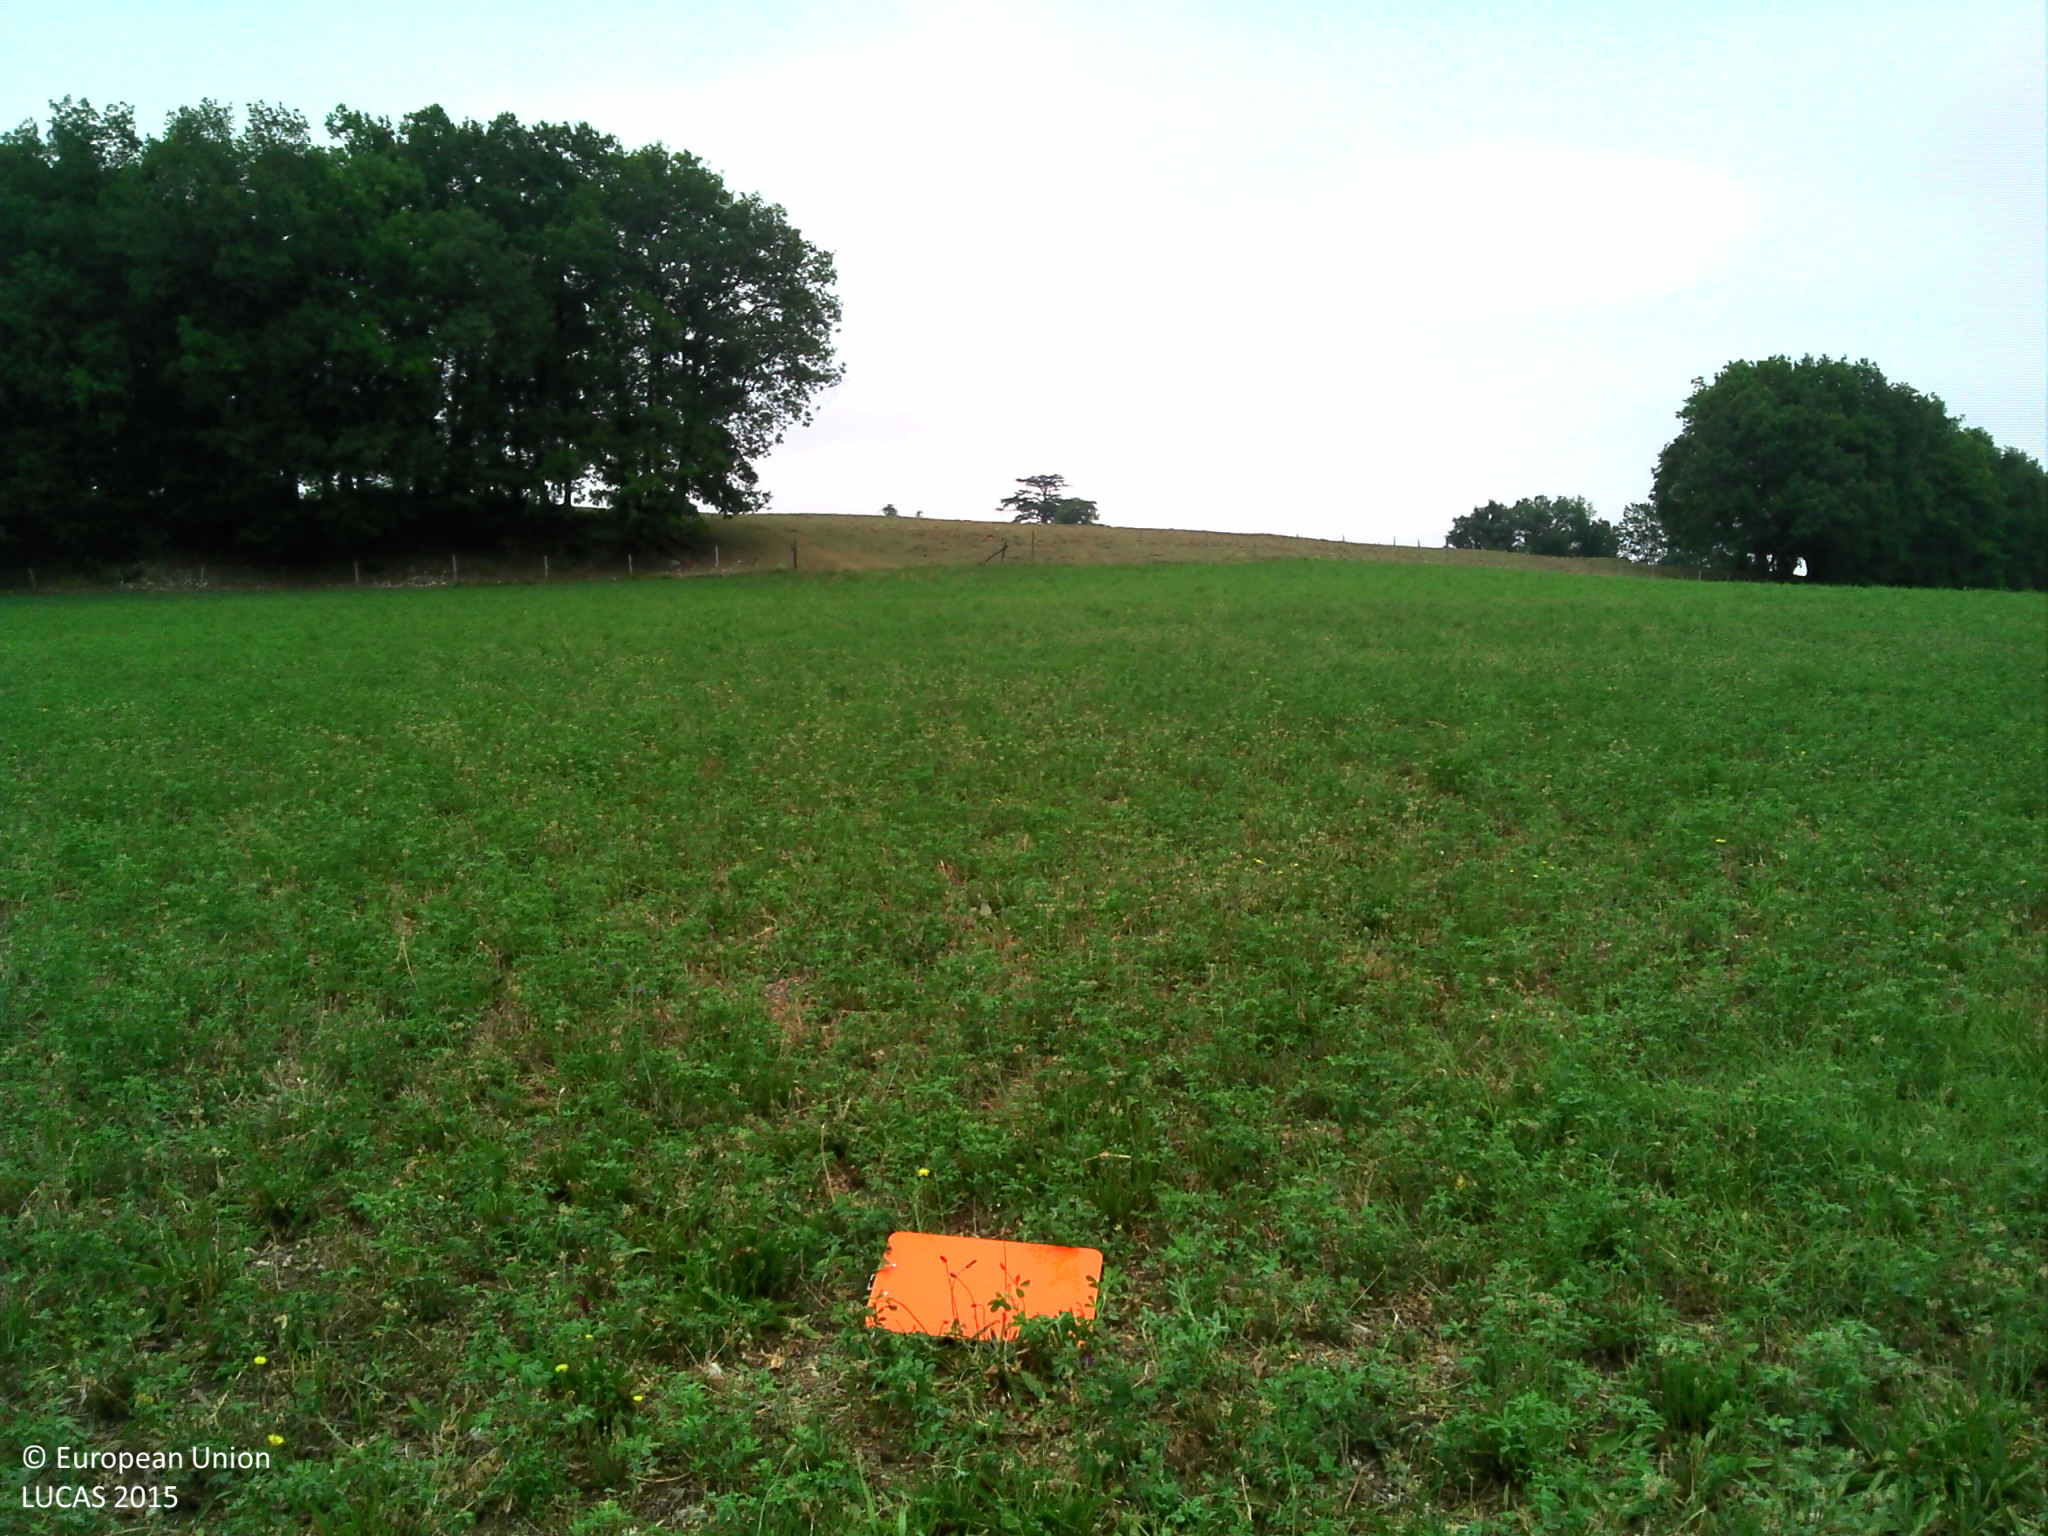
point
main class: Cropland
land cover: Lucerne
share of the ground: > 75 %
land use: Agriculture (excluding fallow land and kitchen gardens)
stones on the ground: 10 - 25 %
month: July
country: FR
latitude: 44.2732
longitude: 0.8625
